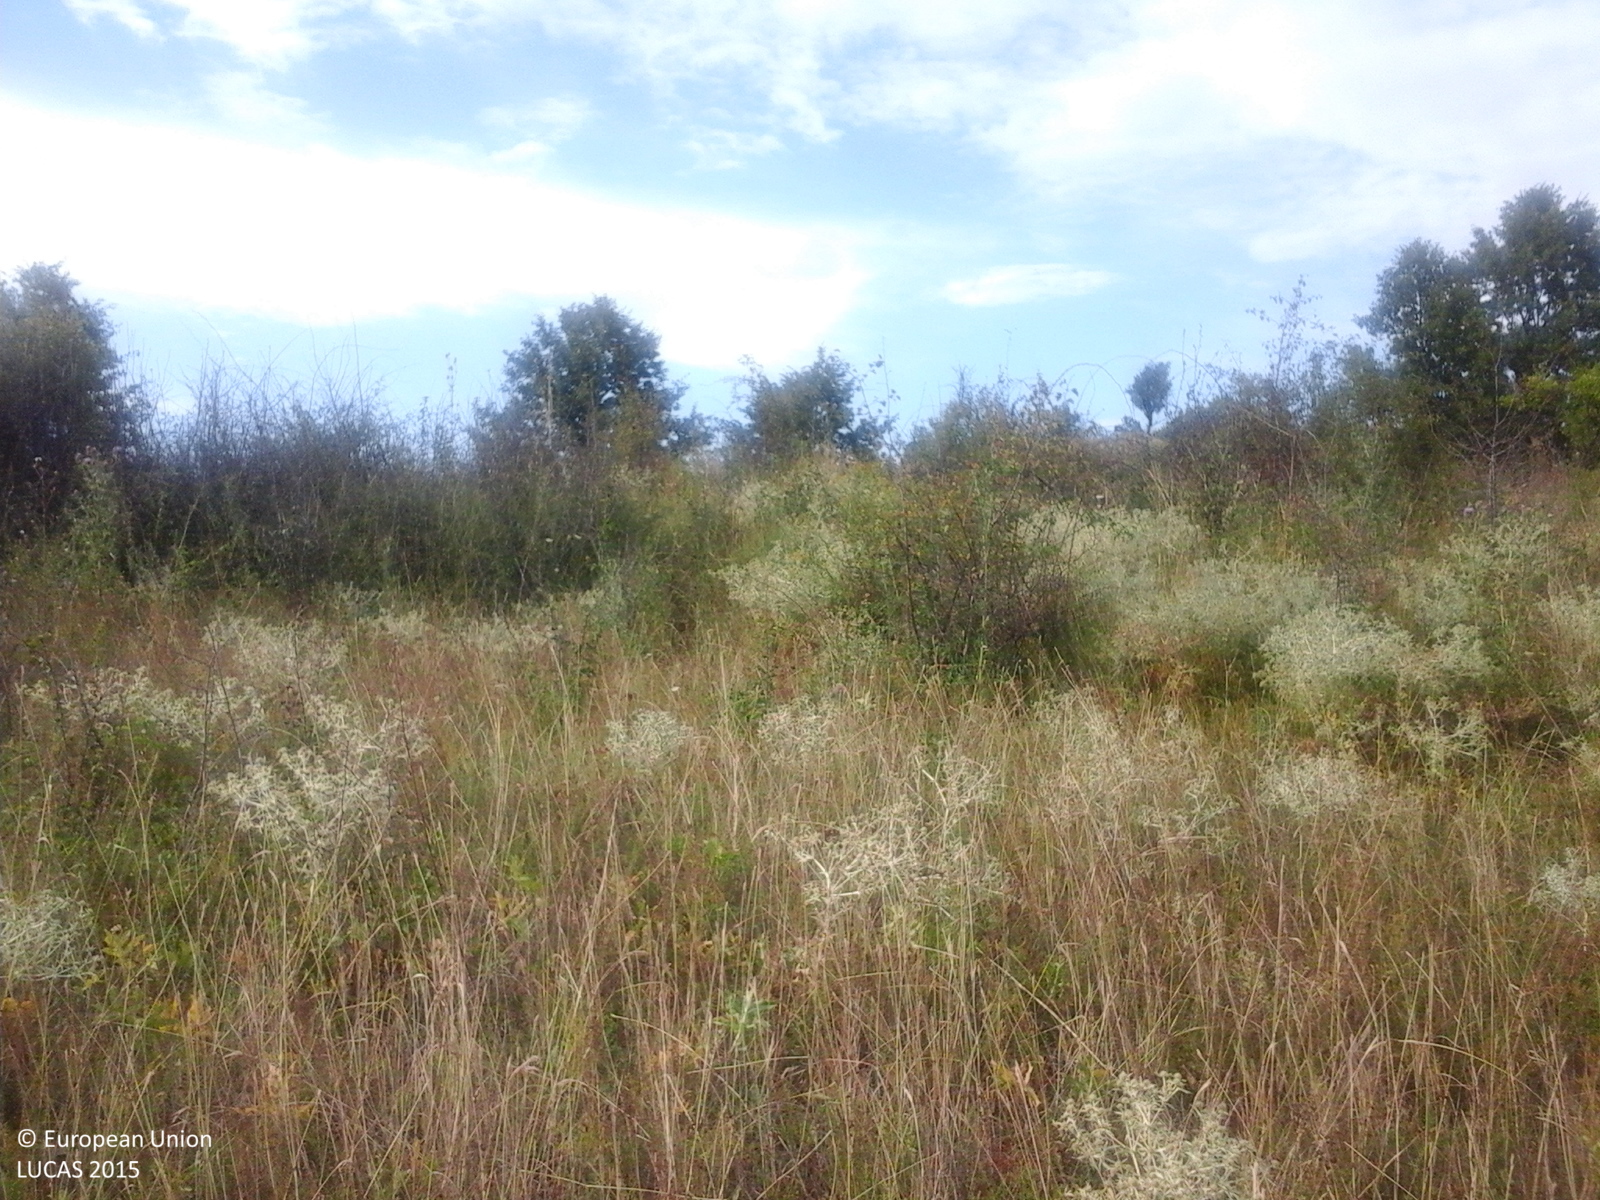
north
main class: Grassland
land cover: Spontaneously vegetated surfaces
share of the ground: > 75 %
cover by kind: herbaceous plants 100 %
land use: Fallow land
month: August
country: RO
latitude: 44.8000
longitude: 22.9032
